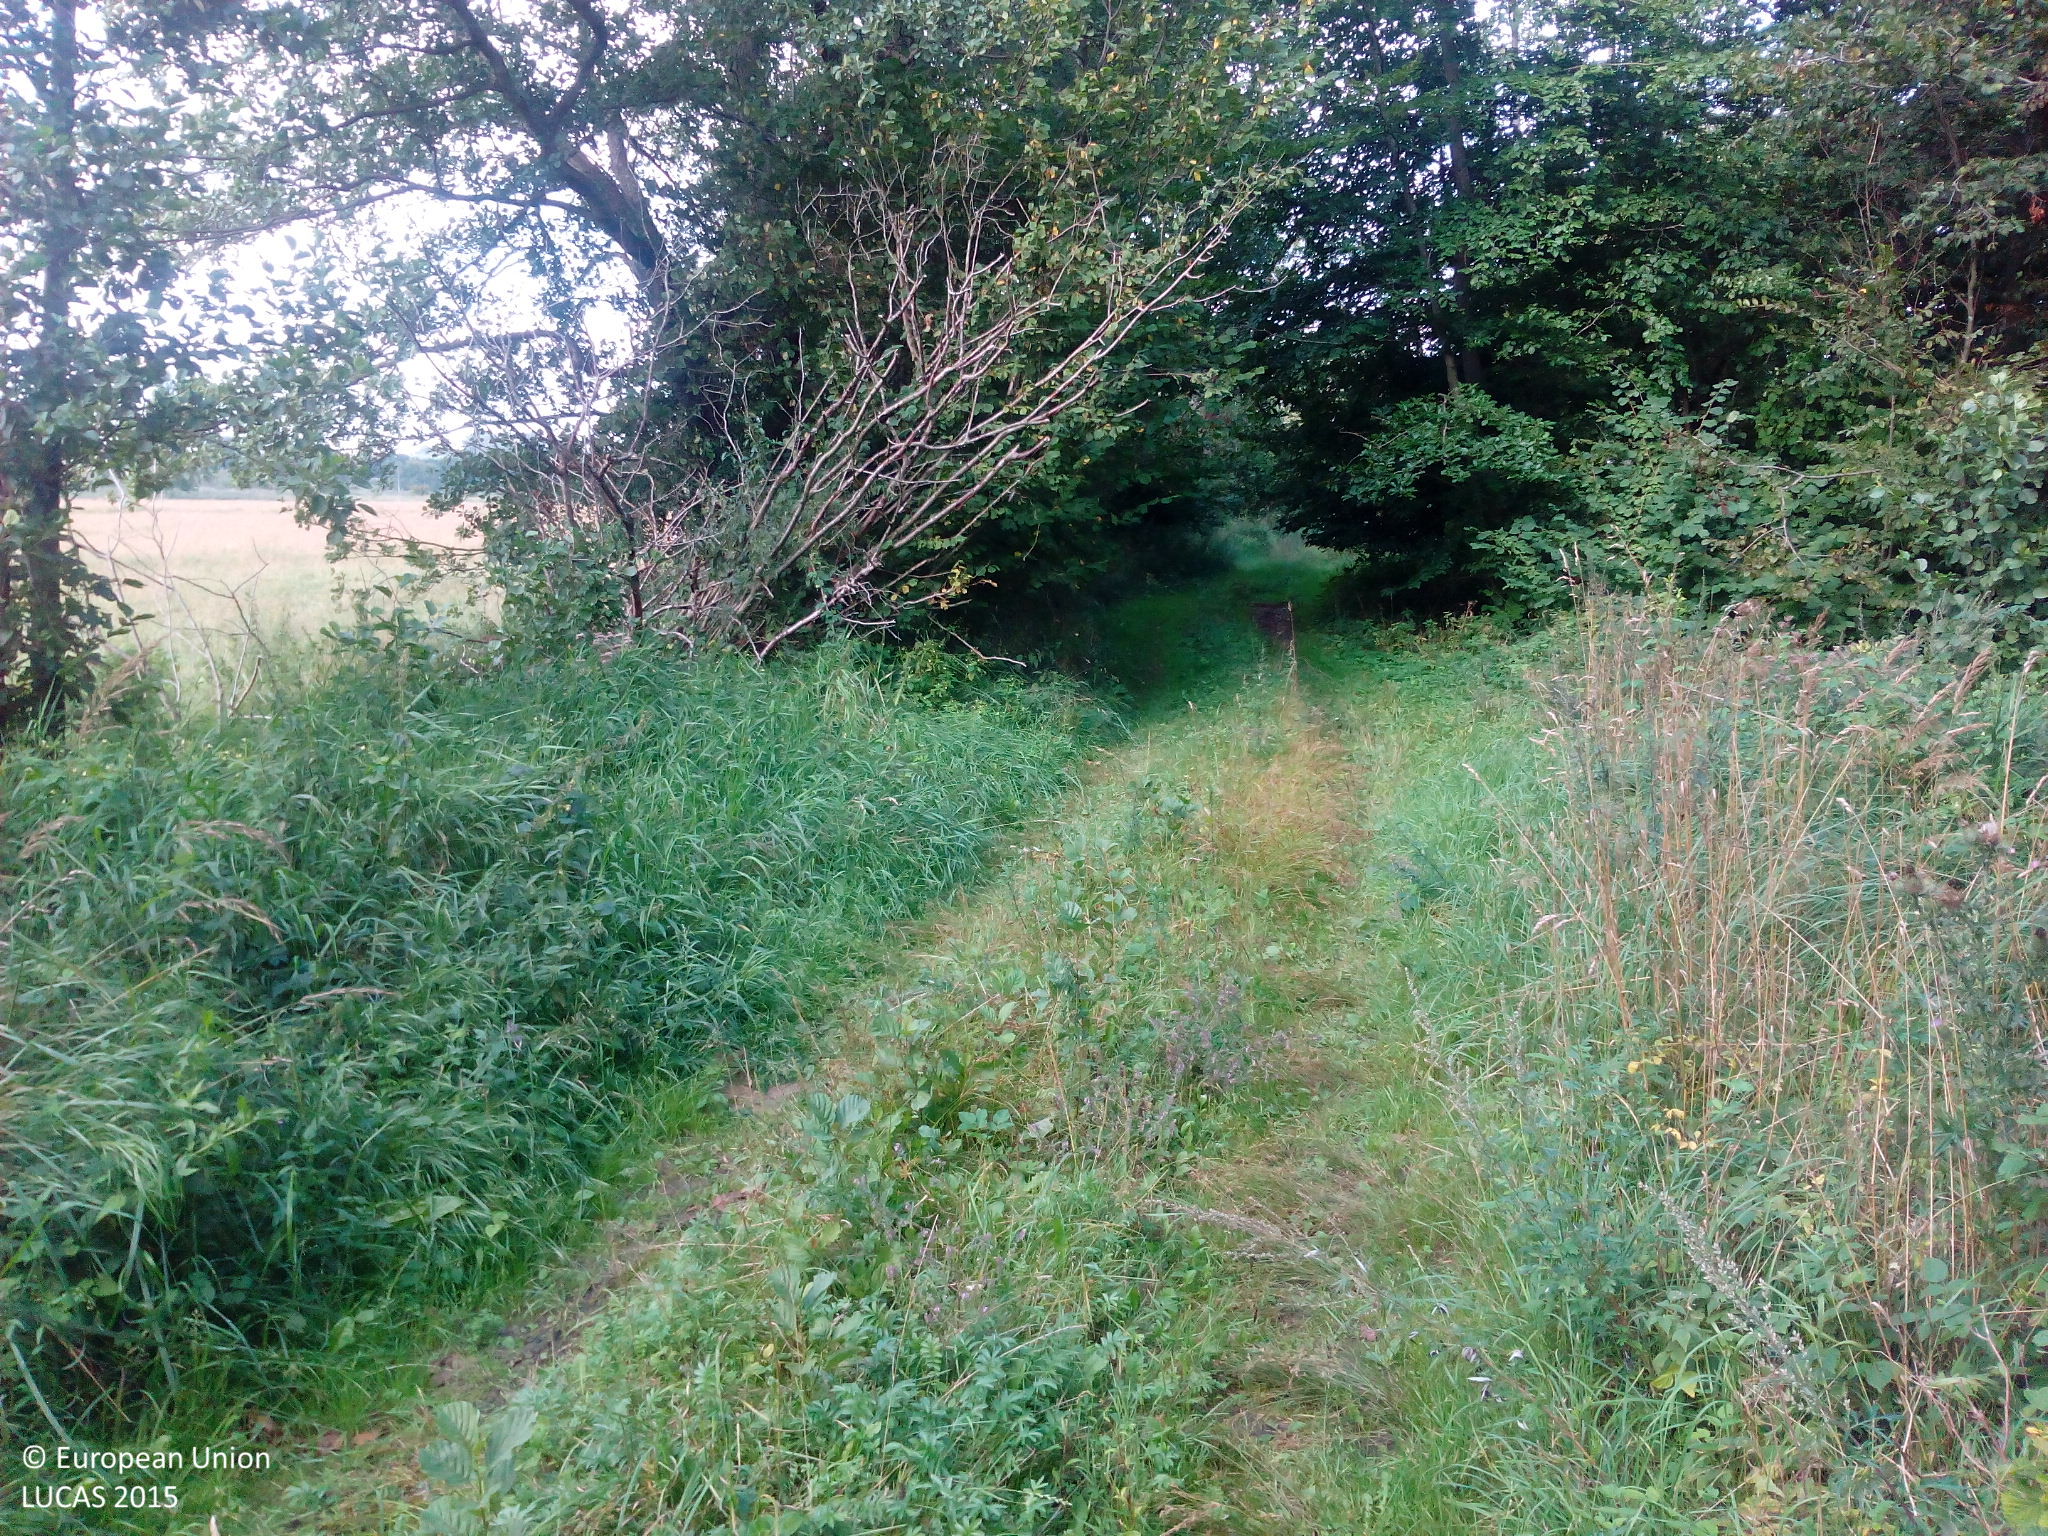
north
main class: Woodland
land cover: Broadleaved woodland
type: mesophytic deciduous forest
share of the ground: 50 - 75 %
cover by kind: broadleaved forest trees 50 %, shrubs 40 %, herbaceous plants 10 %
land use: Forestry
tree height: > 5 m
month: August
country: DE
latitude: 54.0751
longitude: 12.6125
